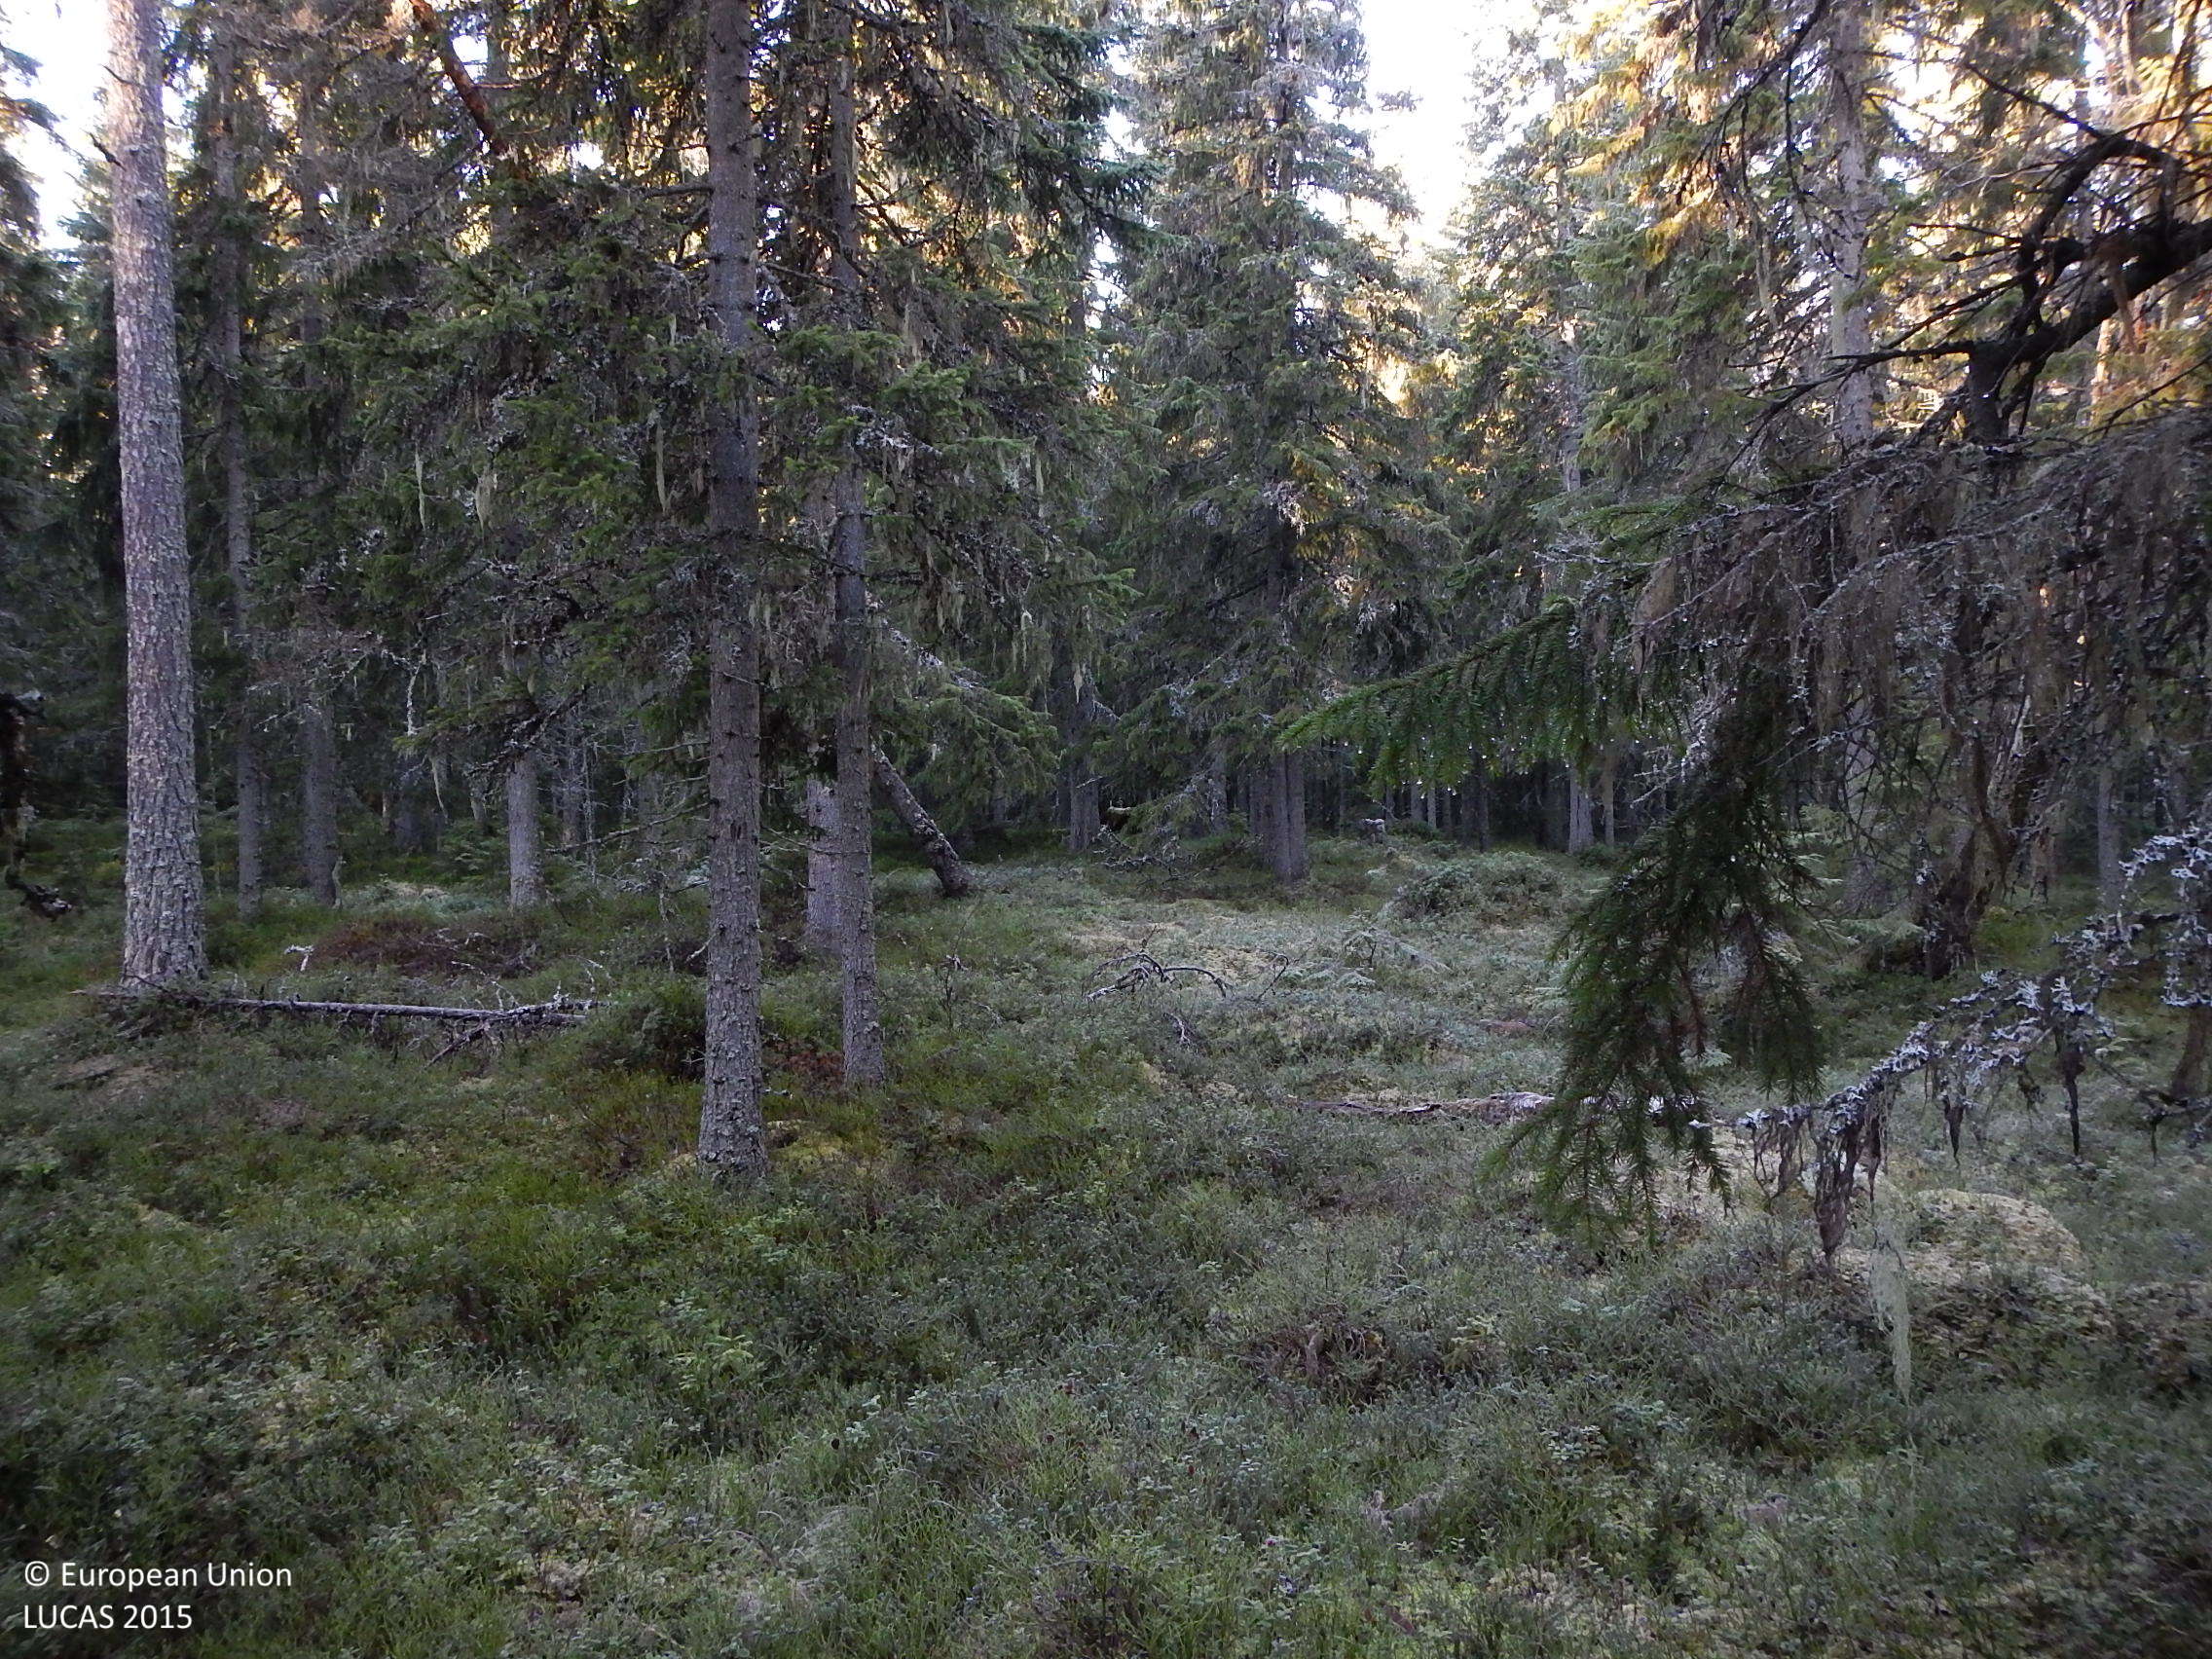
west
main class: Woodland
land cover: Spruce dominated coniferous woodland
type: boreal forest
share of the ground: 50 - 75 %
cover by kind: coniferous forest trees 50 %, shrubs 30 %, lichens and mosses 20 %
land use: Forestry
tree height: > 5 m
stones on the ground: < 10 %
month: November
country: SE
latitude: 61.5920
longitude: 15.9188
